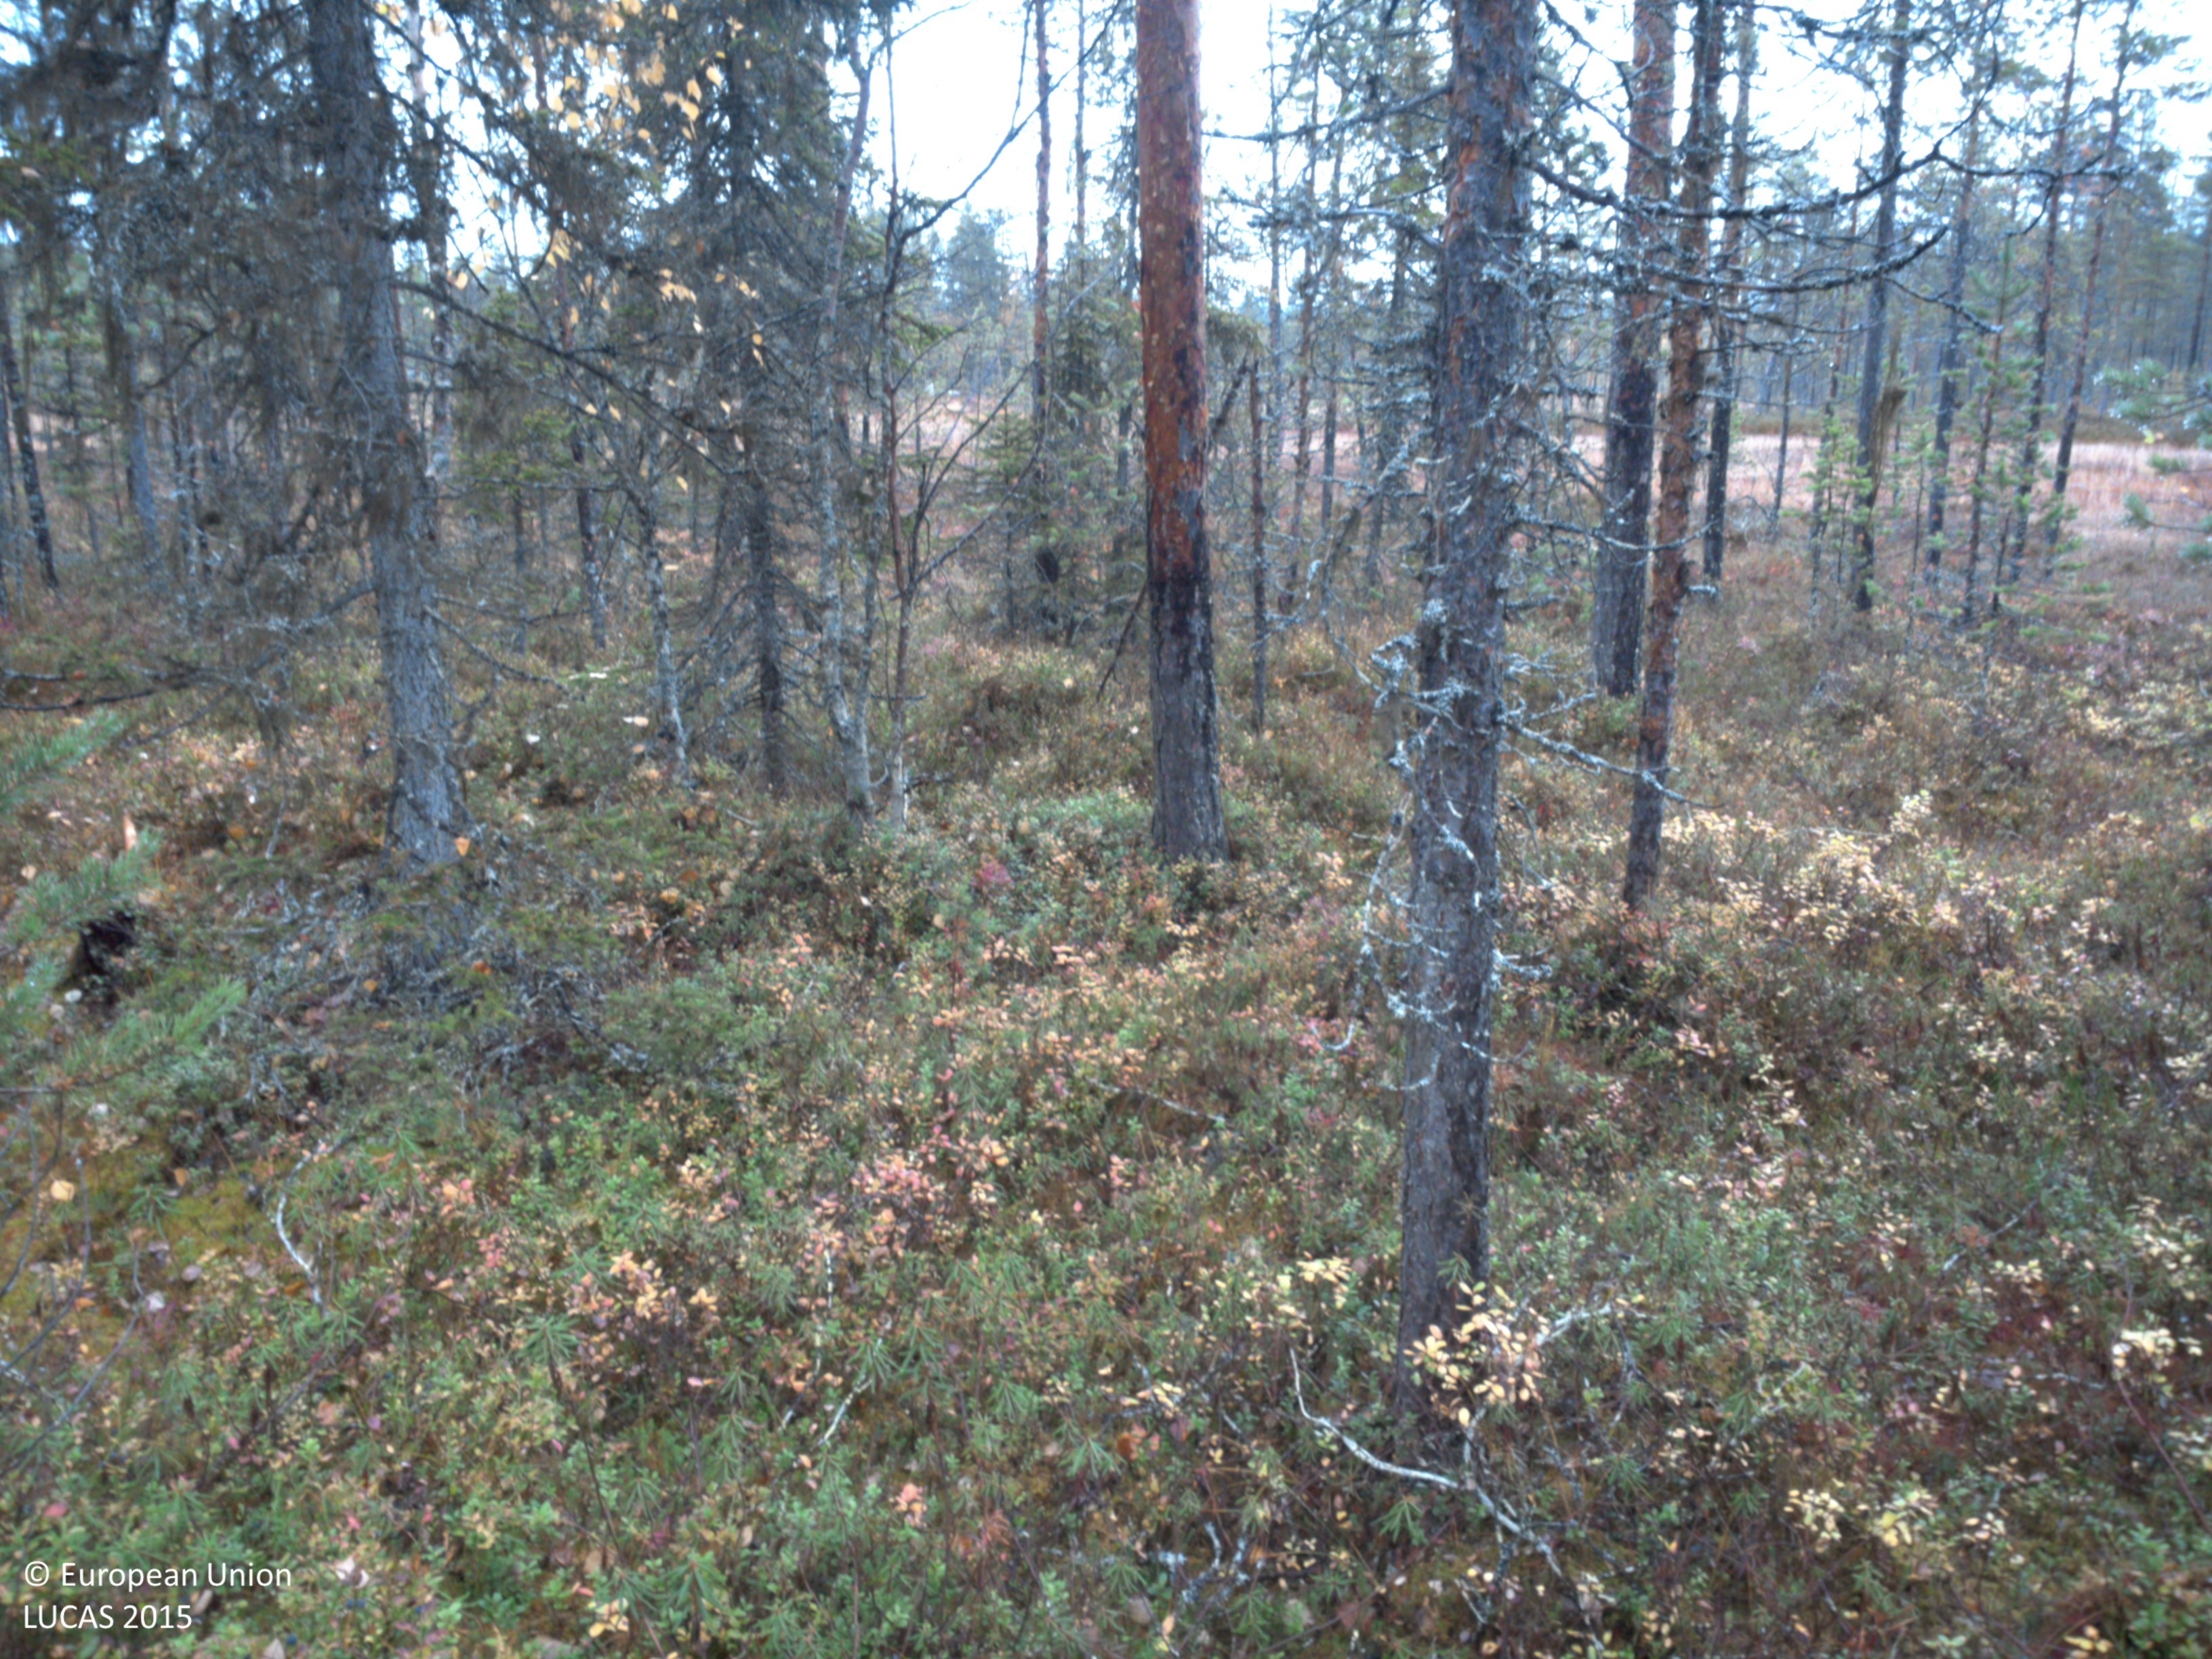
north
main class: Woodland
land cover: Other coniferous woodland
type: boreal forest
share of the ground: 50 - 75 %
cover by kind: coniferous forest trees 60 %, shrubs 25 %, broadleaved forest trees 10 %, lichens and mosses 5 %
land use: Forestry
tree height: > 5 m
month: September
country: SE
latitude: 64.9811
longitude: 18.9720
